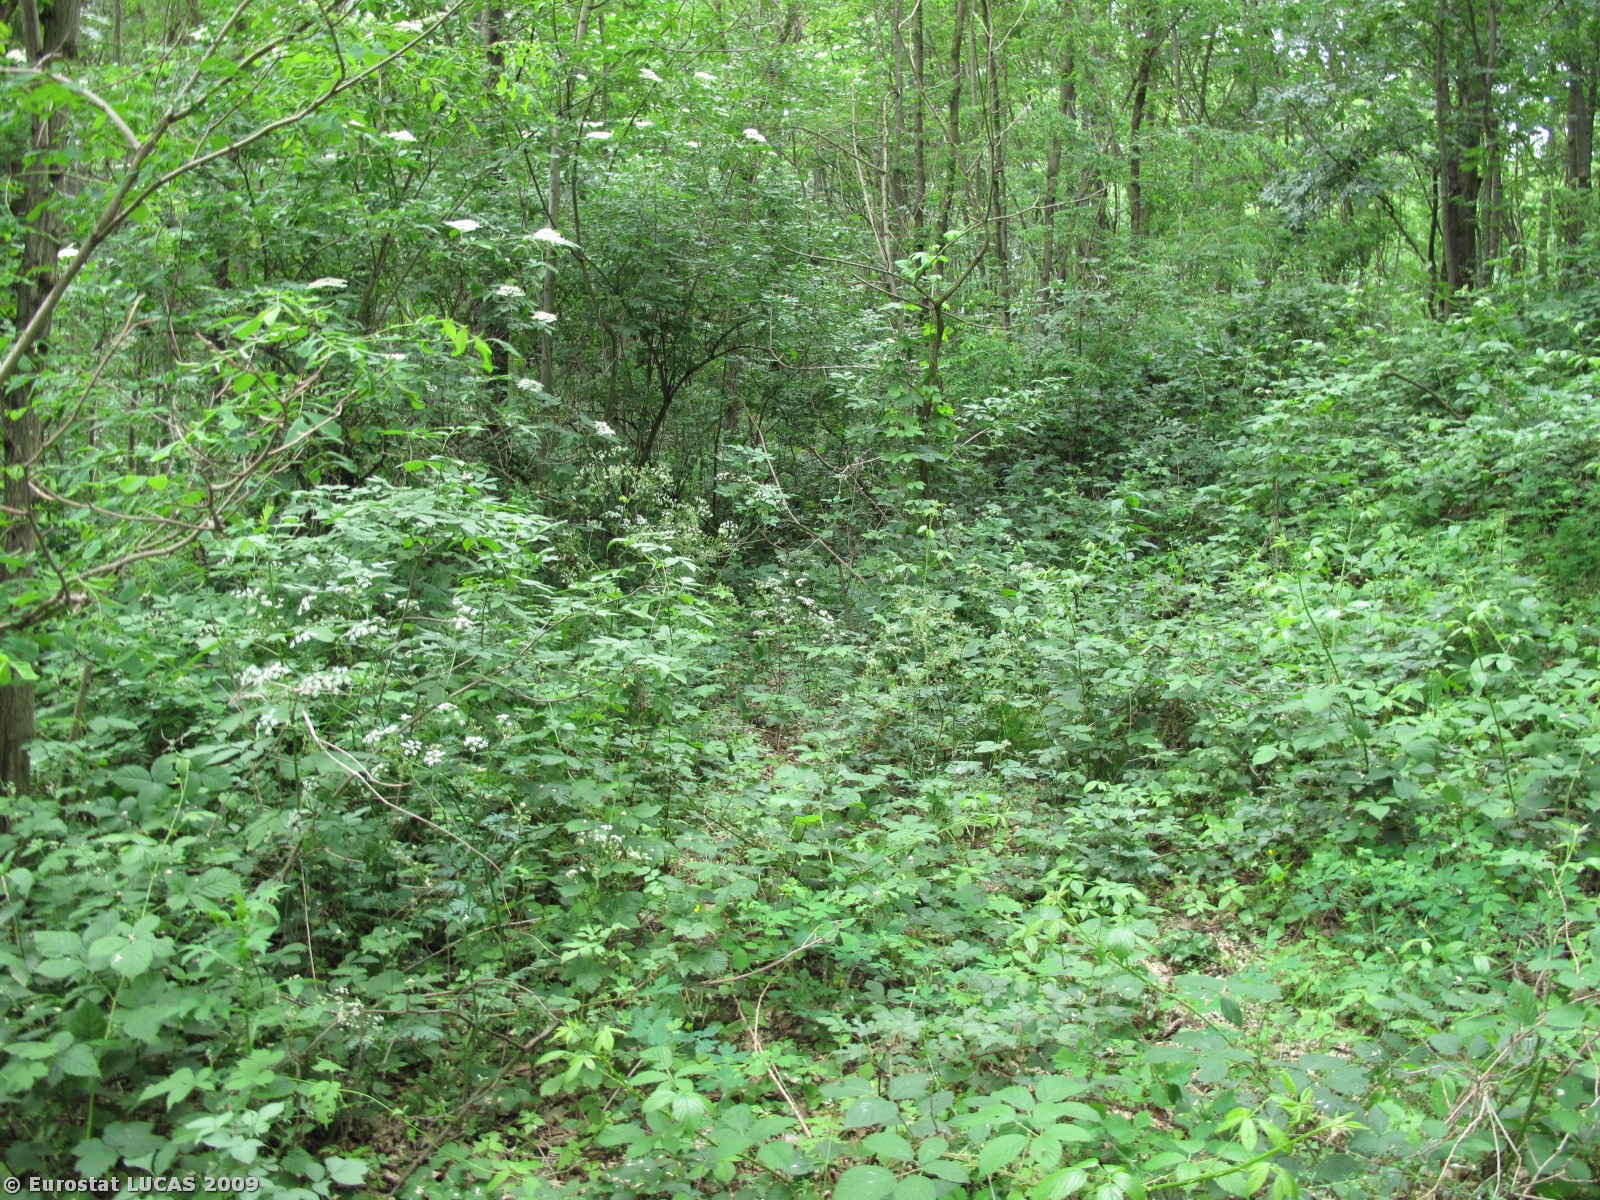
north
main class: Woodland
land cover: Broadleaved woodland
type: mesophytic deciduous forest
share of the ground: 50 - 75 %
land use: Forestry
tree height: > 5 m
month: May
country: AT
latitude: 48.5276
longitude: 16.0301
